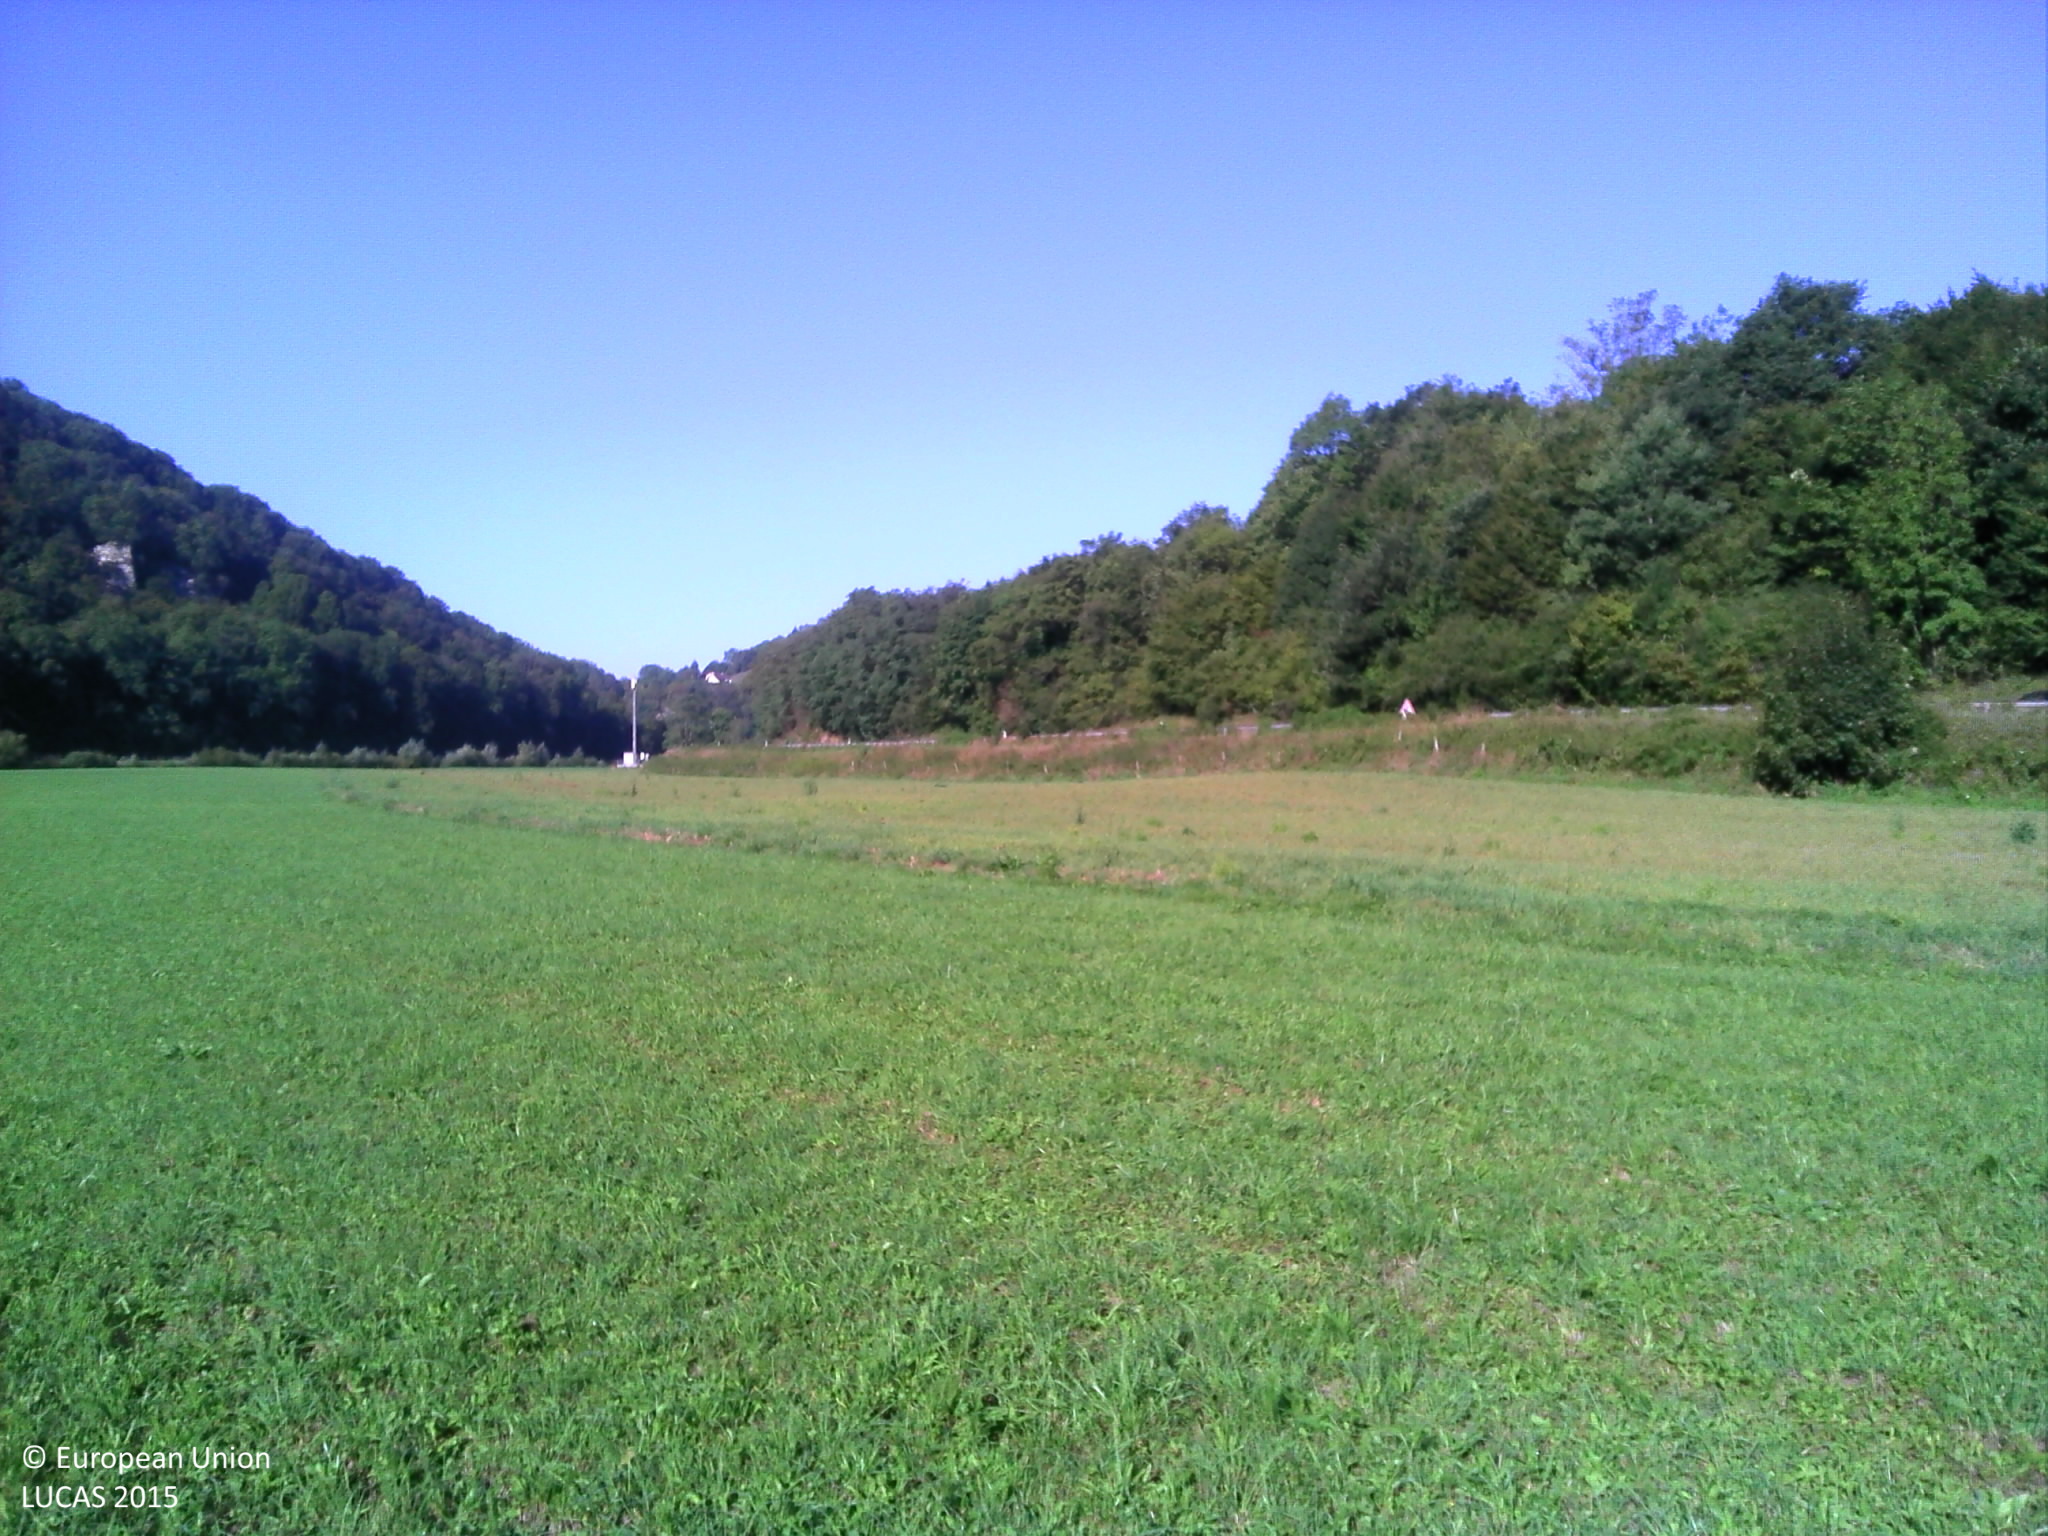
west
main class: Grassland
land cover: Grassland without tree/shrub cover
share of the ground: > 75 %
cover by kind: herbaceous plants 100 %
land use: Agriculture (excluding fallow land and kitchen gardens)
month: September
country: FR
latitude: 47.3537
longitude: 6.3876
